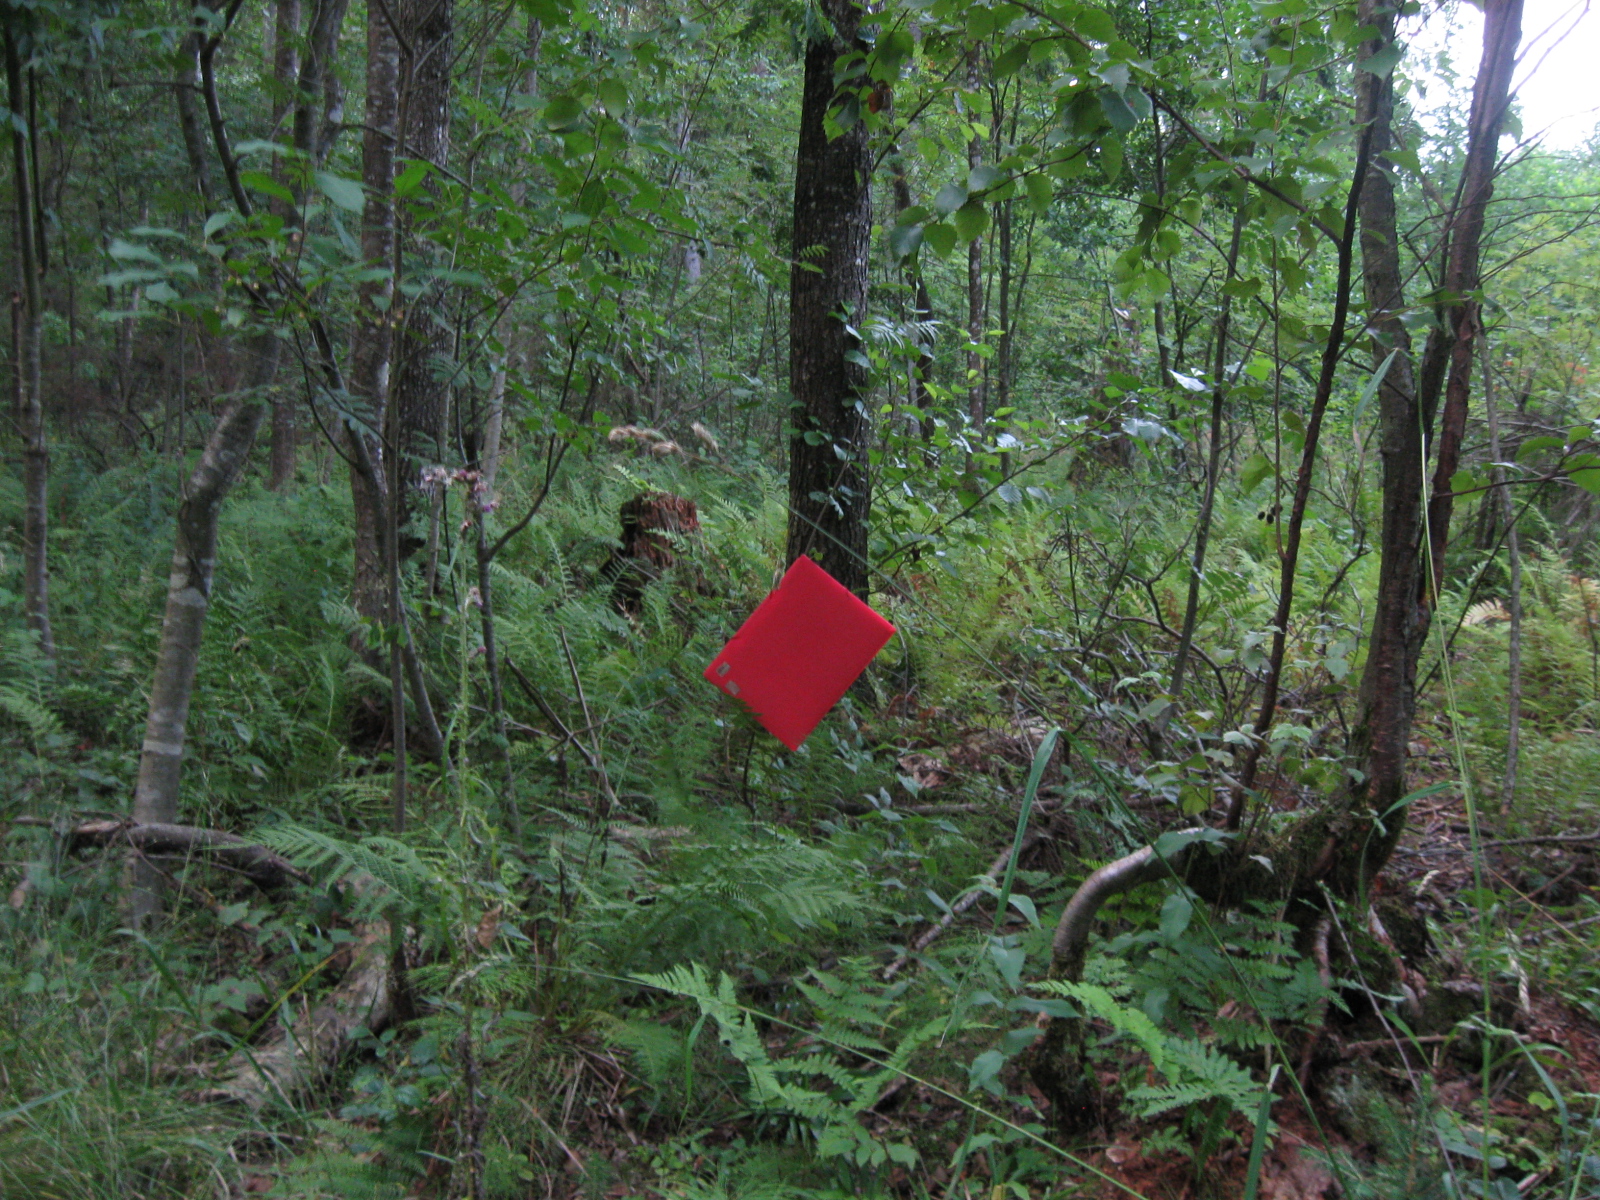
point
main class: Woodland
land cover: Broadleaved woodland
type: non-riverine alder, birch or aspen forest
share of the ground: > 75 %
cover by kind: broadleaved forest trees 80 %, herbaceous plants 15 %, coniferous forest trees 5 %
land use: Forestry
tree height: > 5 m
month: July
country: LT
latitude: 54.7392
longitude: 23.8341
